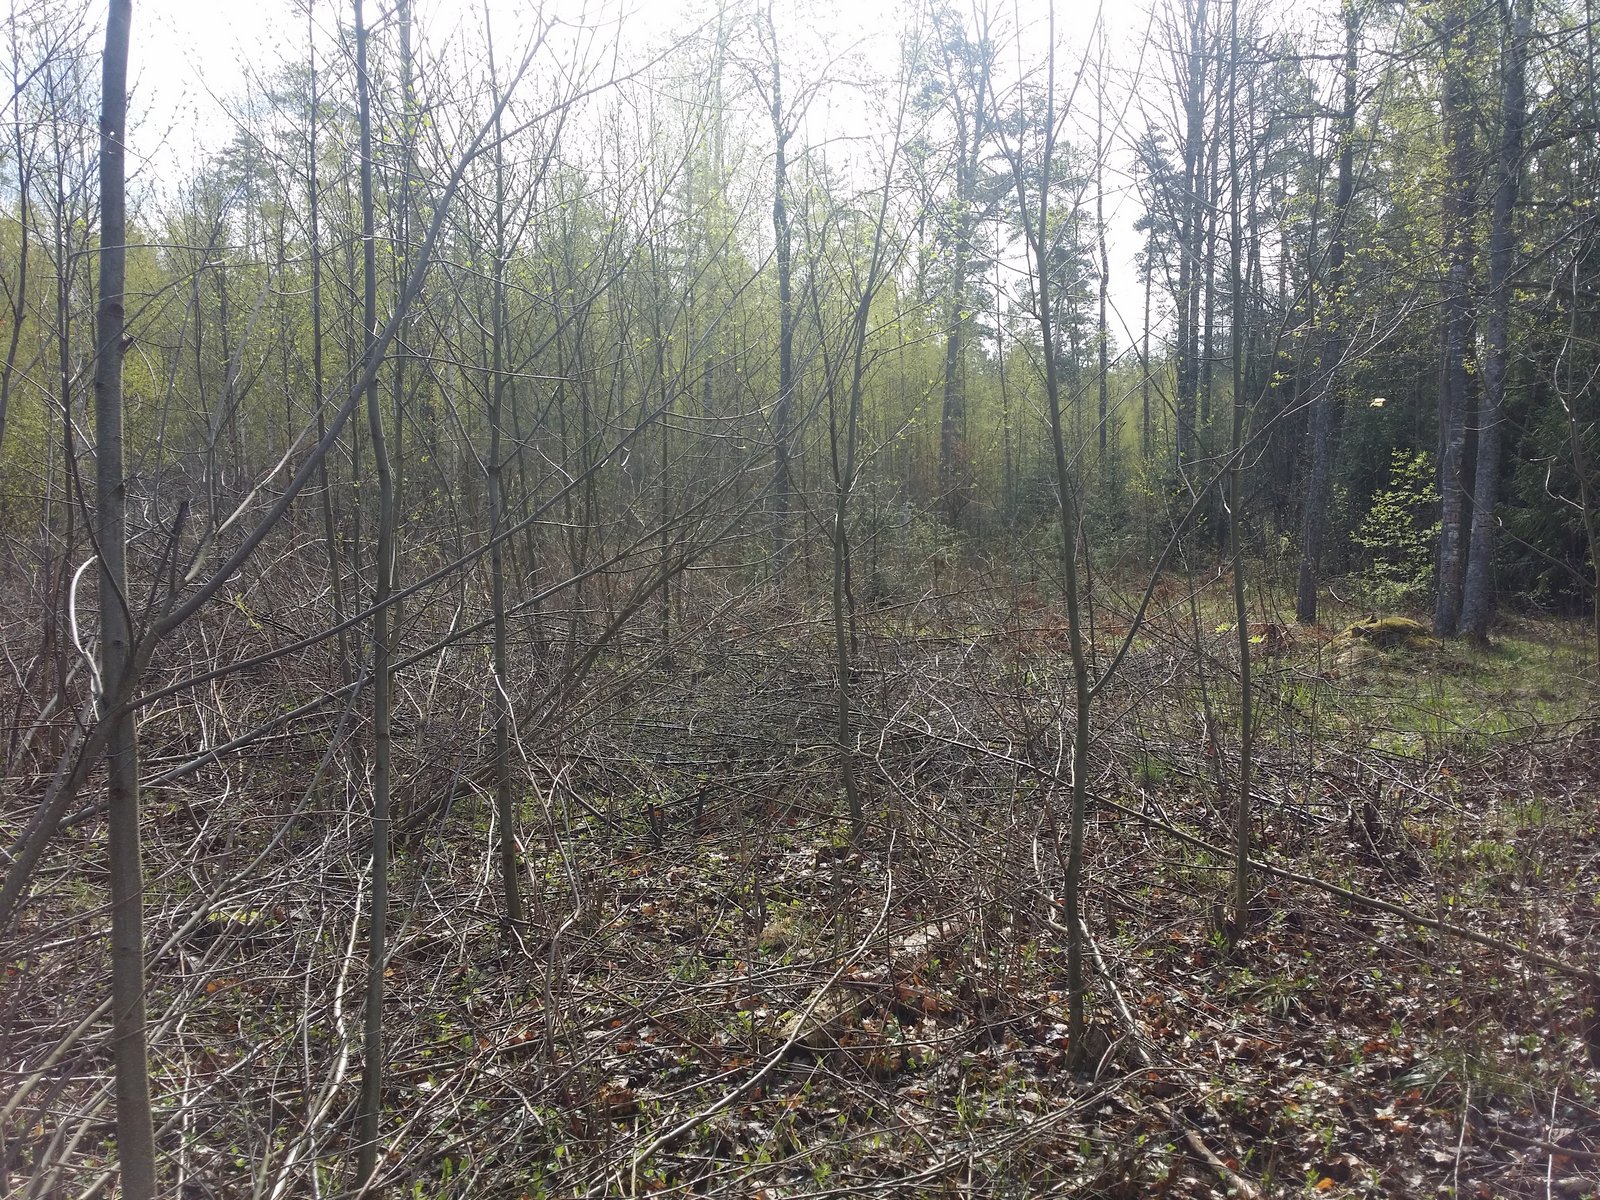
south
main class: Woodland
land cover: Broadleaved woodland
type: non-riverine alder, birch or aspen forest
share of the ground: 50 - 75 %
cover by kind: broadleaved forest trees 70 %, herbaceous plants 30 %
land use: Forestry
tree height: < 5 m
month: May
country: LV
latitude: 57.3999
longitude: 25.9881
